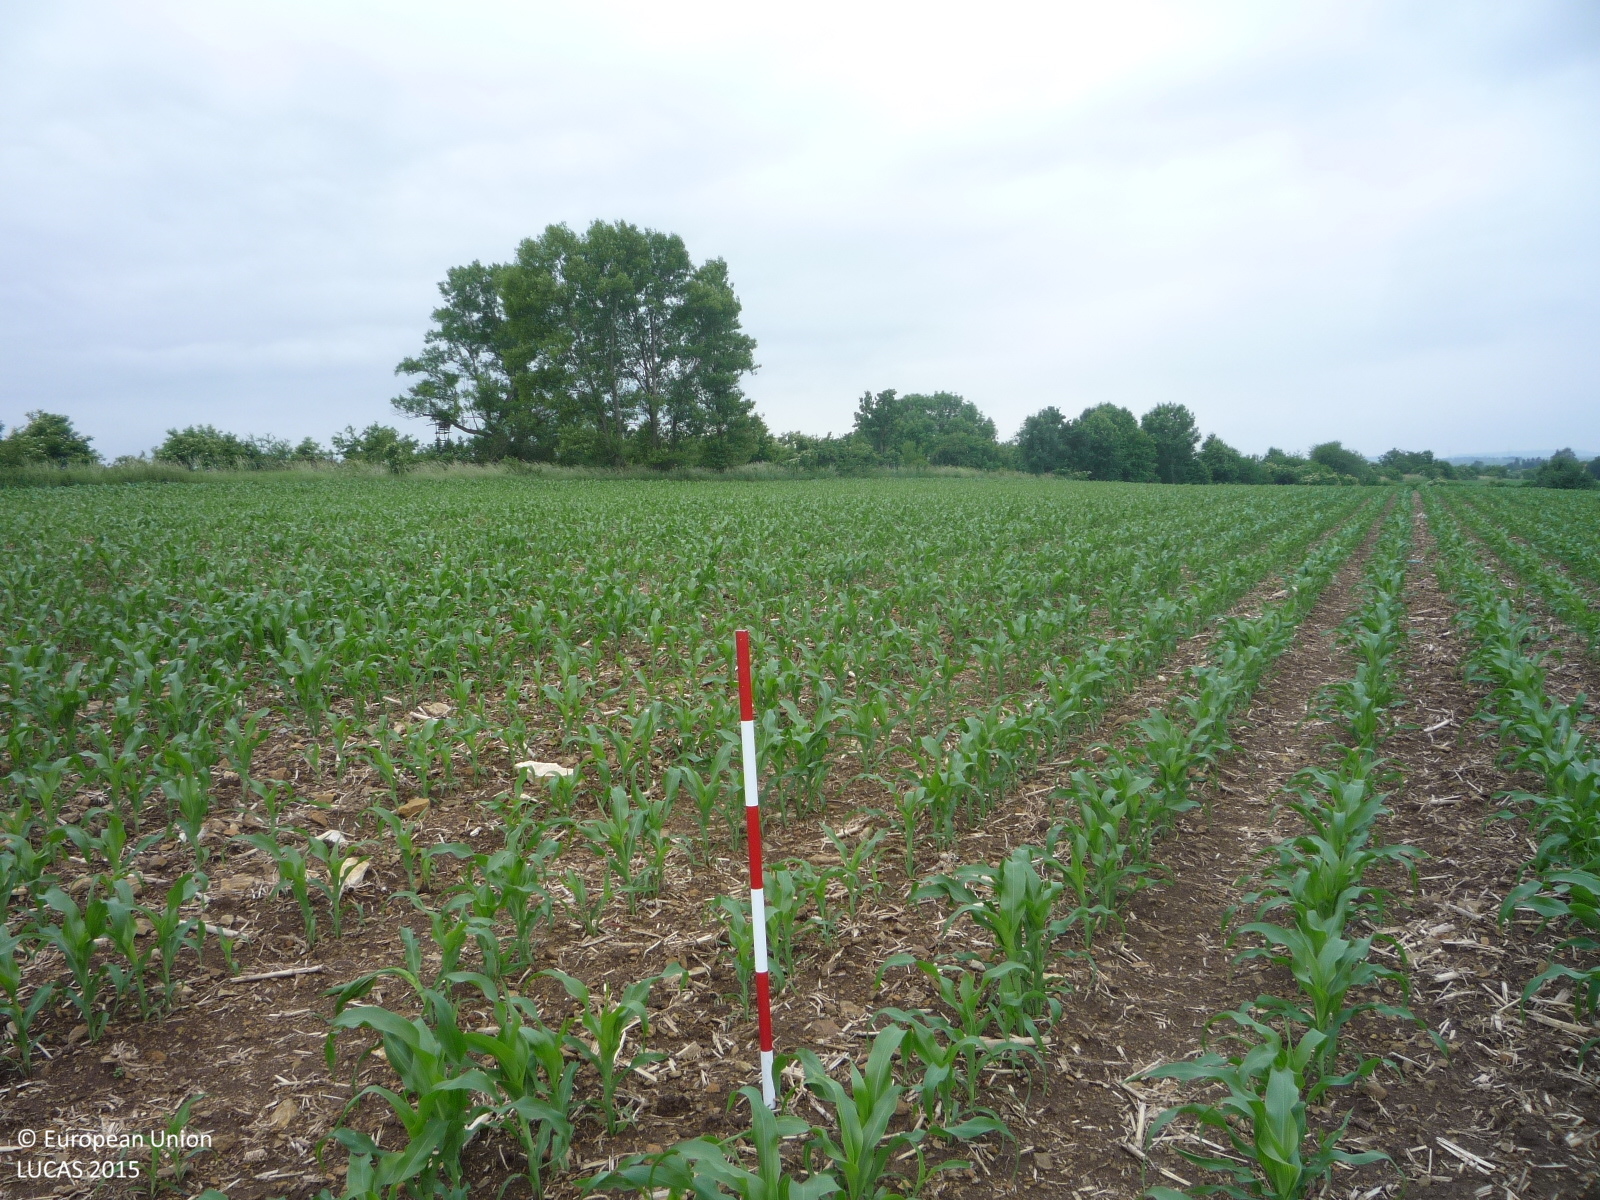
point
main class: Cropland
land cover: Maize
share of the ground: 25 - 50 %
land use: Agriculture (excluding fallow land and kitchen gardens)
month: June
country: CZ
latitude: 50.3348
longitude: 13.8643
